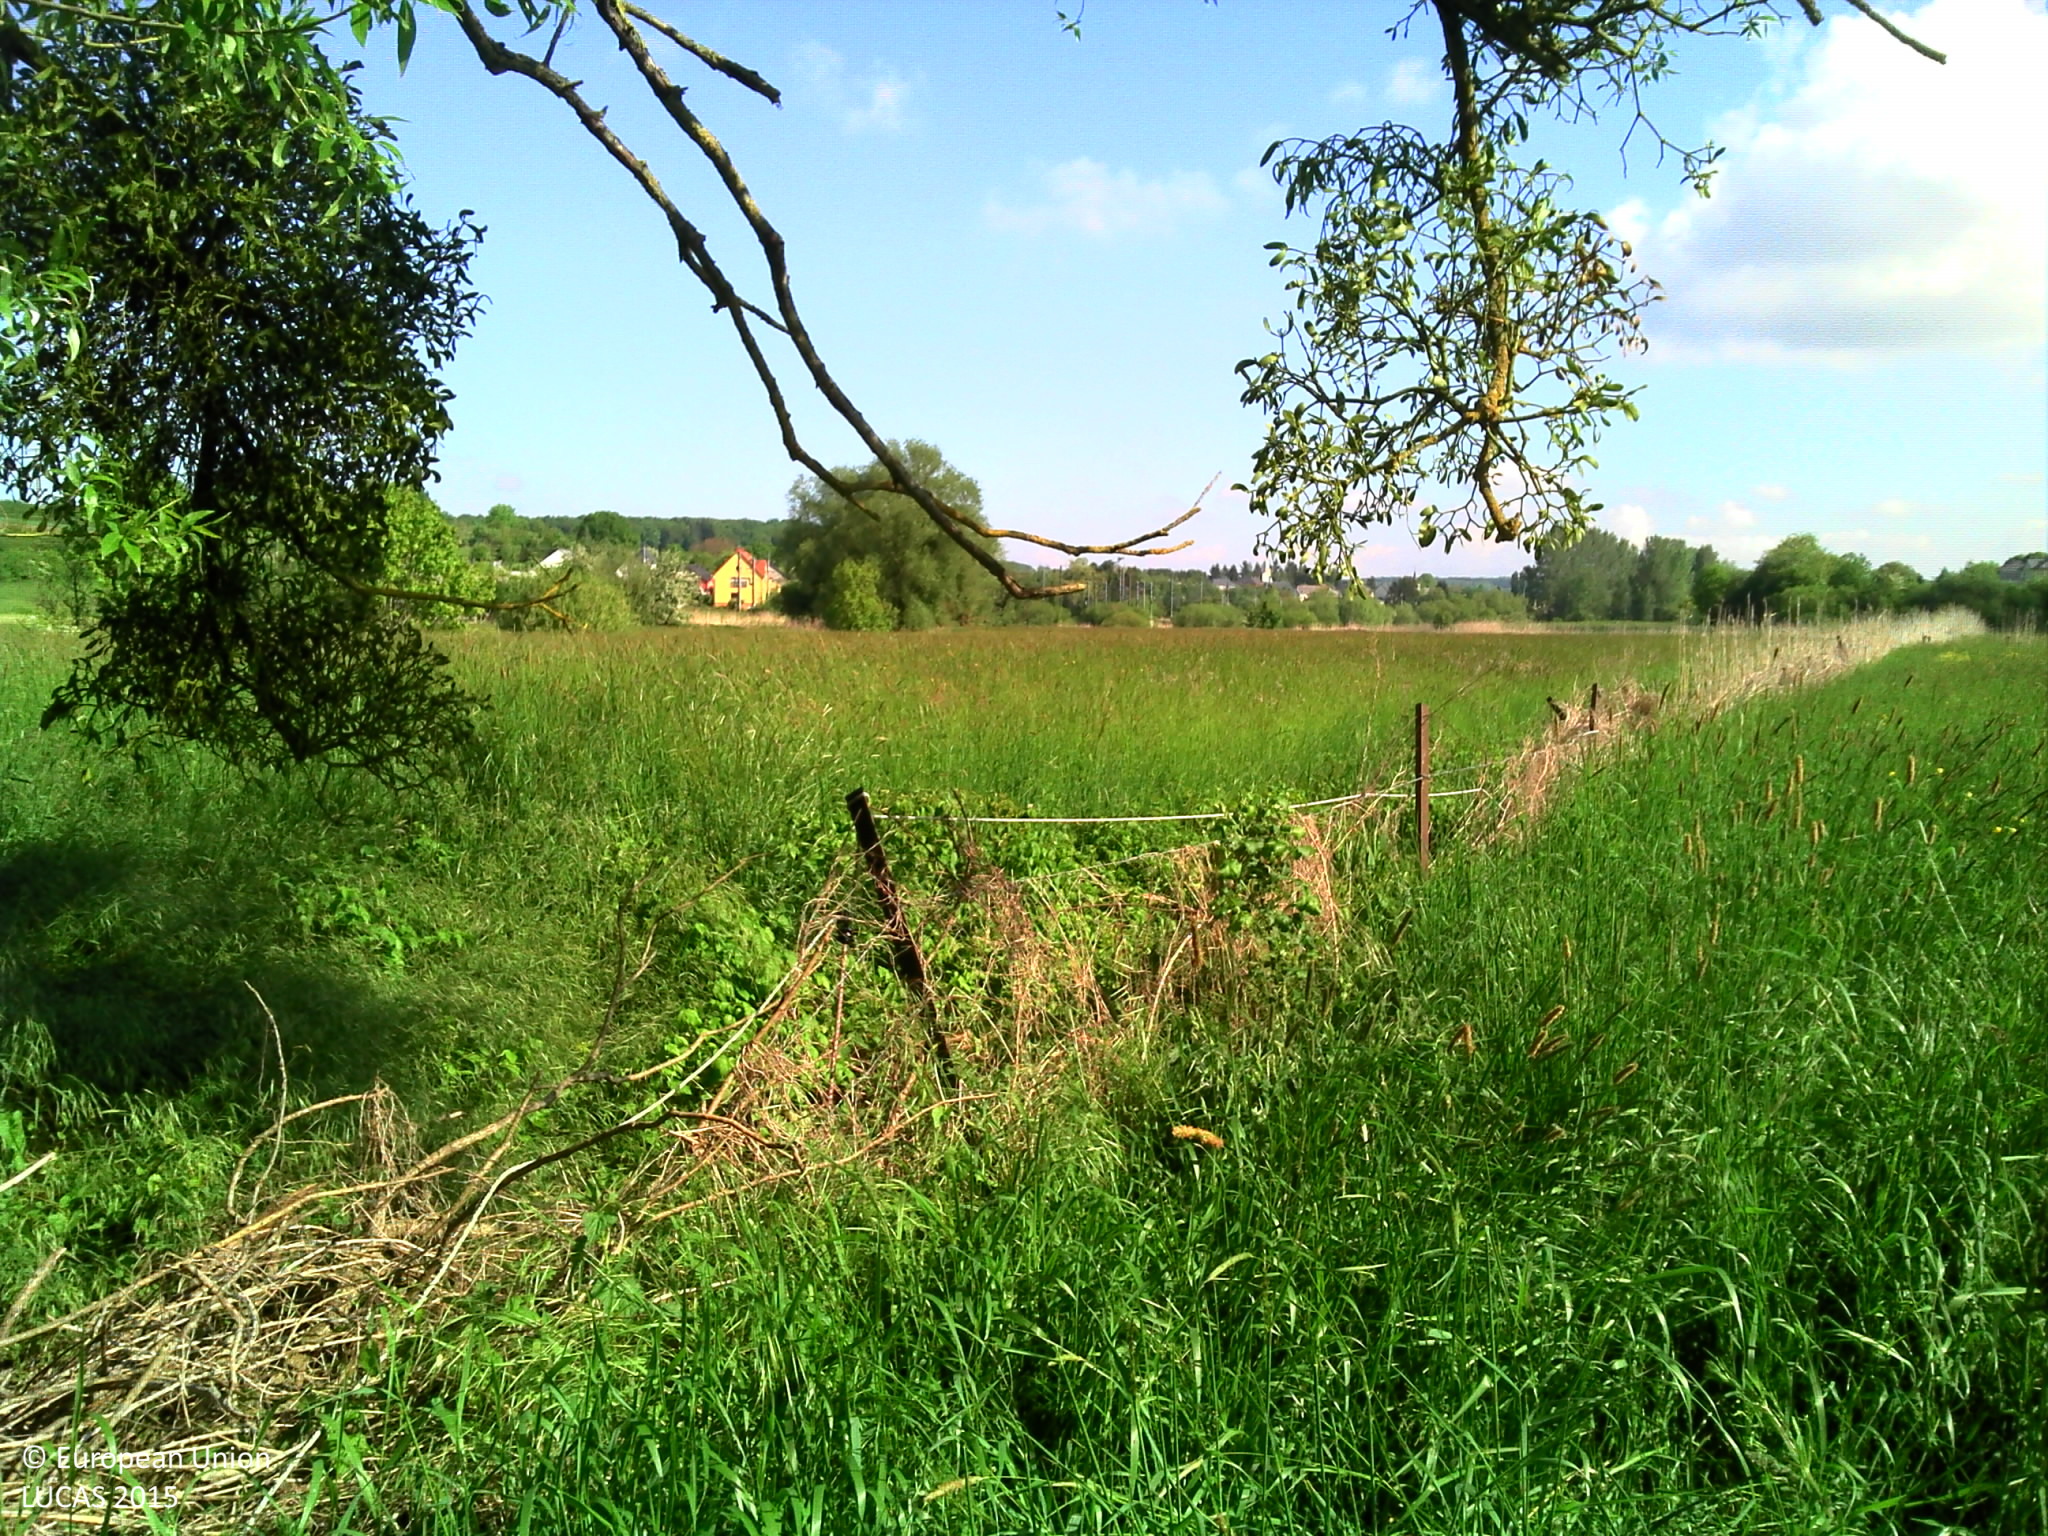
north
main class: Woodland
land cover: Broadleaved woodland
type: floodplain forest
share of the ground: > 75 %
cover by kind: broadleaved forest trees 80 %, herbaceous plants 15 %, shrubs 5 %
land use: Agriculture (excluding fallow land and kitchen gardens)
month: May
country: LU
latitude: 49.6562
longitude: 6.3010
